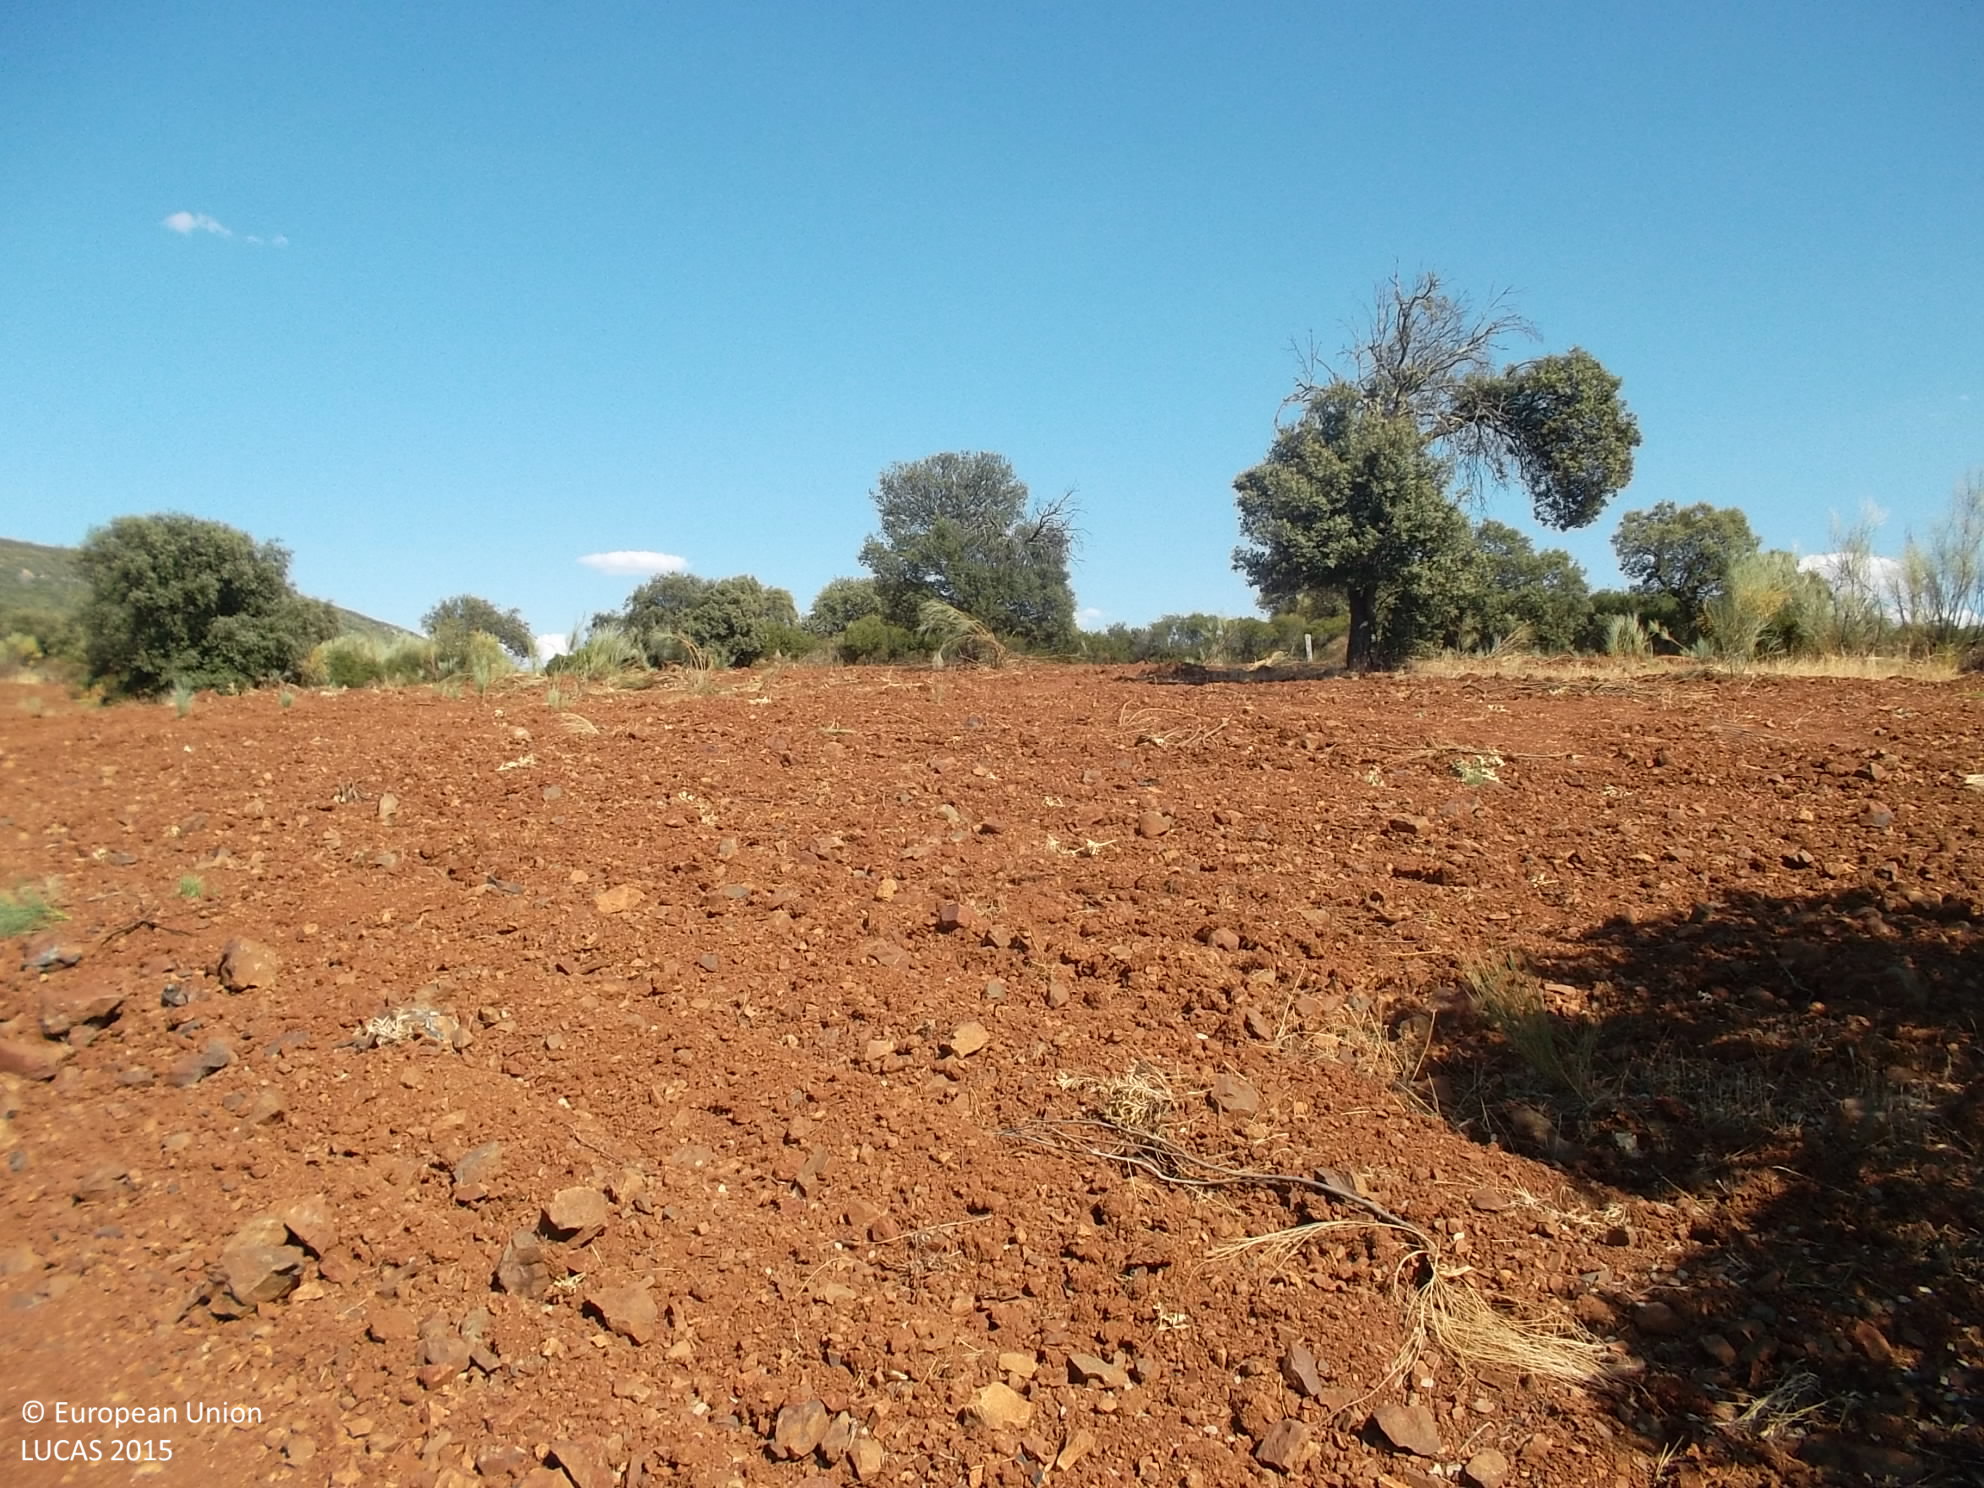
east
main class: Woodland
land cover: Broadleaved woodland
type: broadleaved evergreen forest
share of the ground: 10 - 25 %
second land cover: Spontaneously vegetated surfaces
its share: 10 - 25 %
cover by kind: unconsolidated bare surface 60 %, broadleaved forest trees 25 %, shrubs 15 %
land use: Agriculture (excluding fallow land and kitchen gardens)
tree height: > 5 m
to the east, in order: Broadleaved woodland; Spontaneously vegetated surfaces; Fences; Shruby margins; Tracks; Shruby margins; Broadleaved woodland
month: July
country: ES
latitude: 38.5627
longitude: -5.7518
